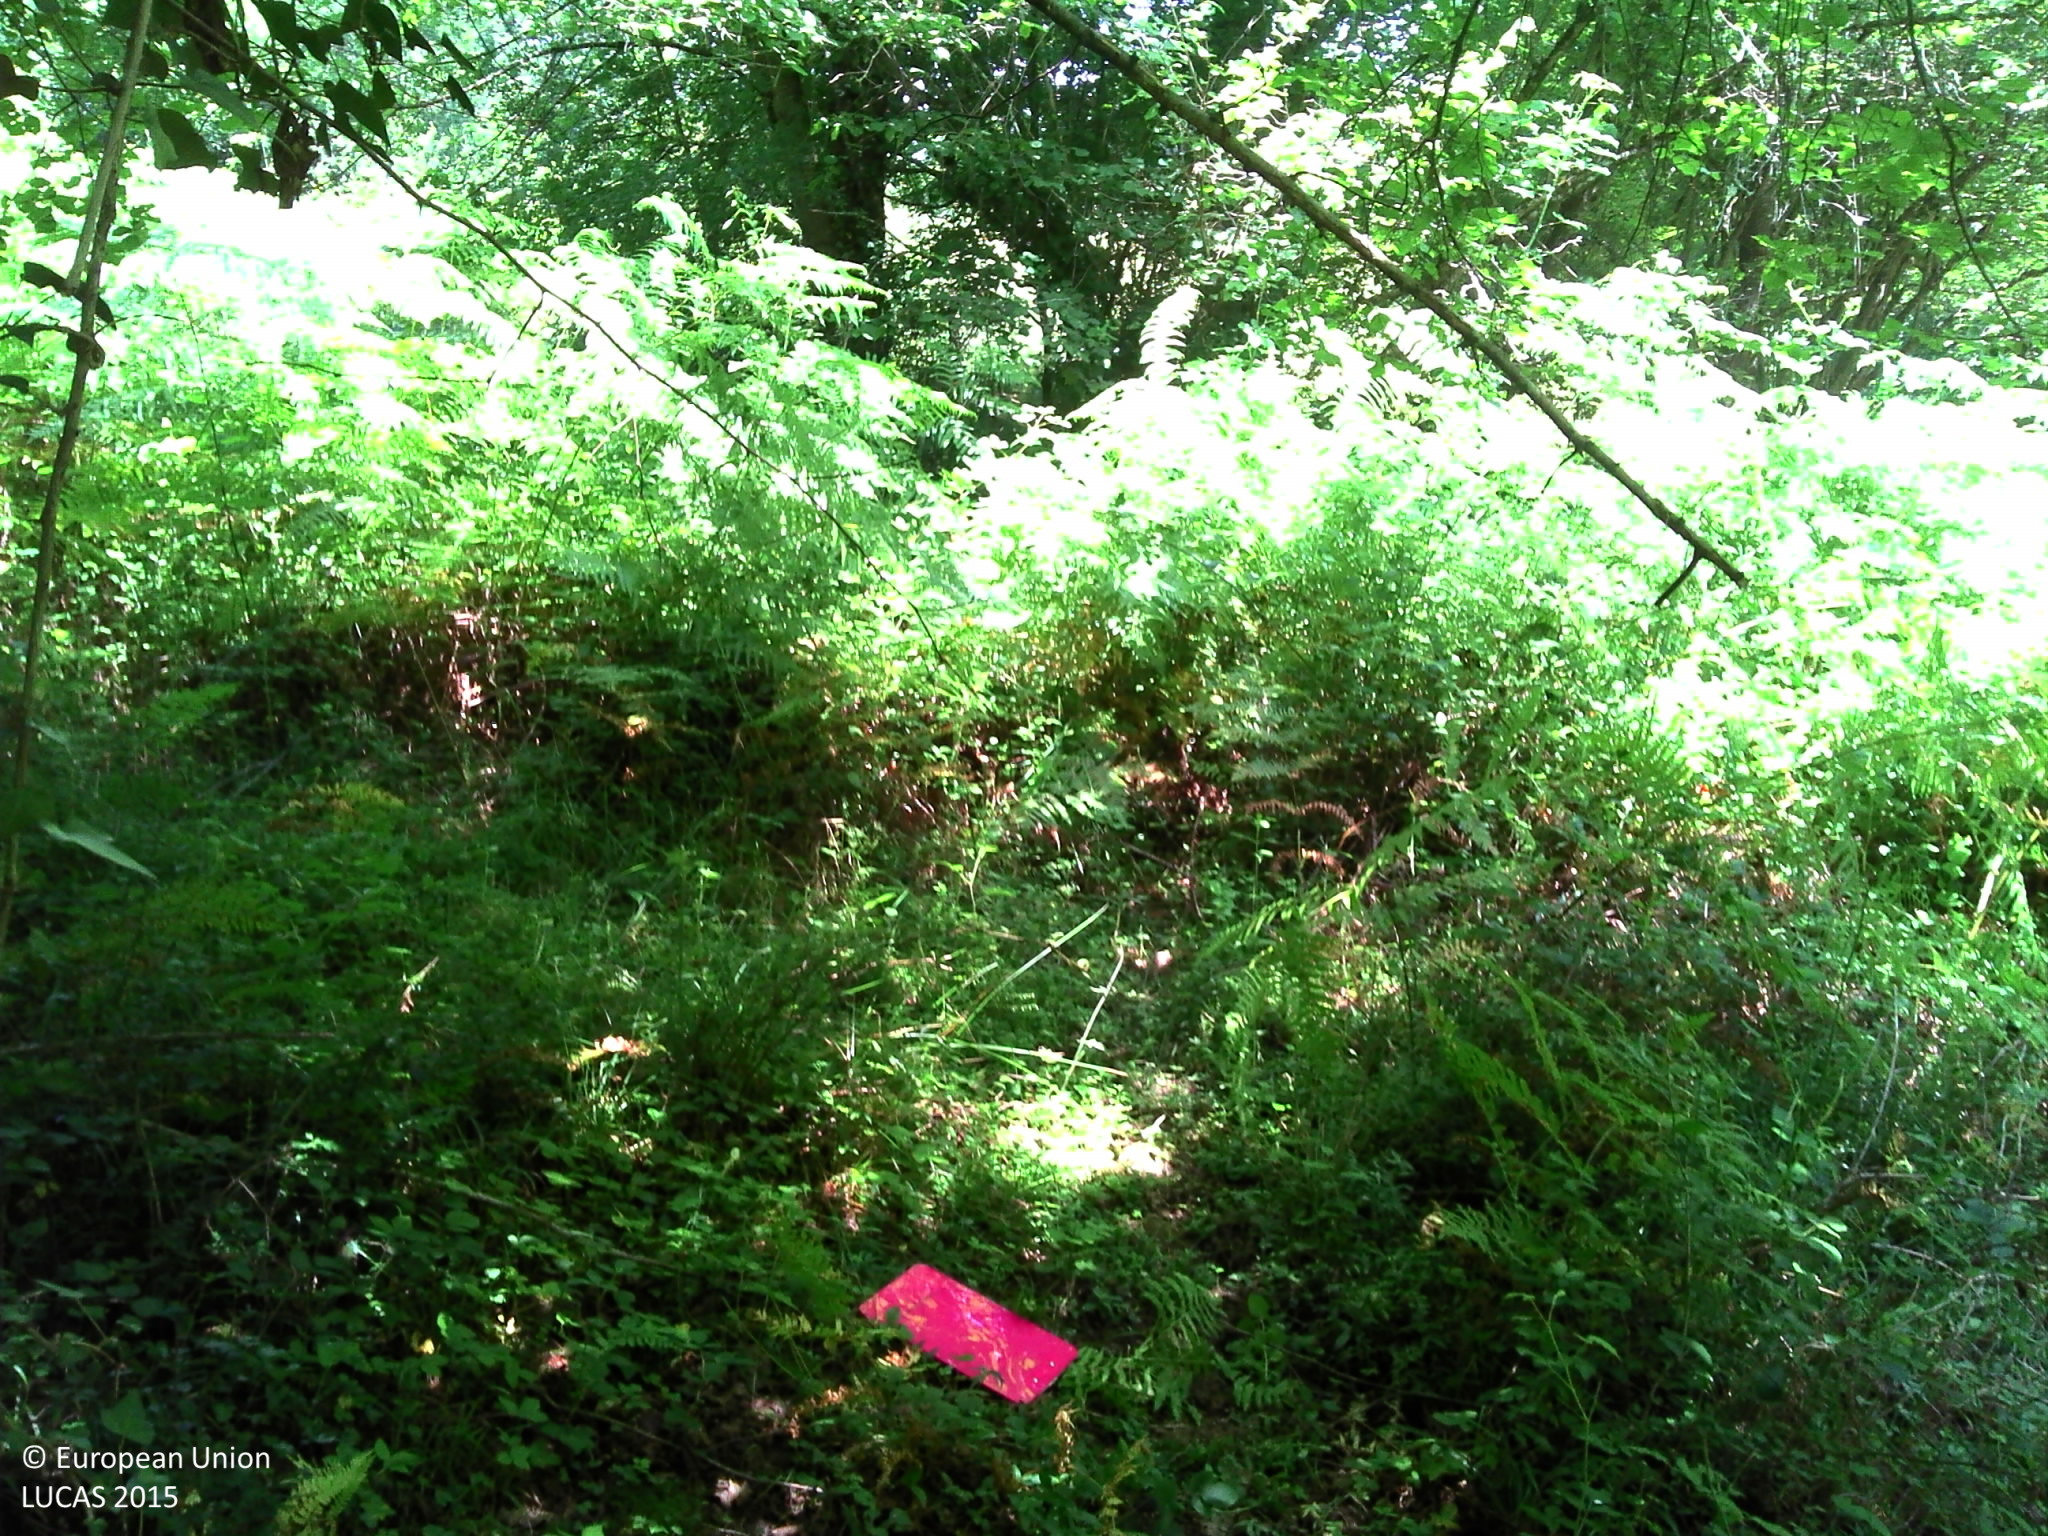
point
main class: Woodland
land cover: Broadleaved woodland
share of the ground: > 75 %
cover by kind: broadleaved forest trees 50 %, shrubs 40 %, herbaceous plants 10 %
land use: Agriculture (excluding fallow land and kitchen gardens)
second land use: Forestry
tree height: > 5 m
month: July
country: FR
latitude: 43.0541
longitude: 1.0289
